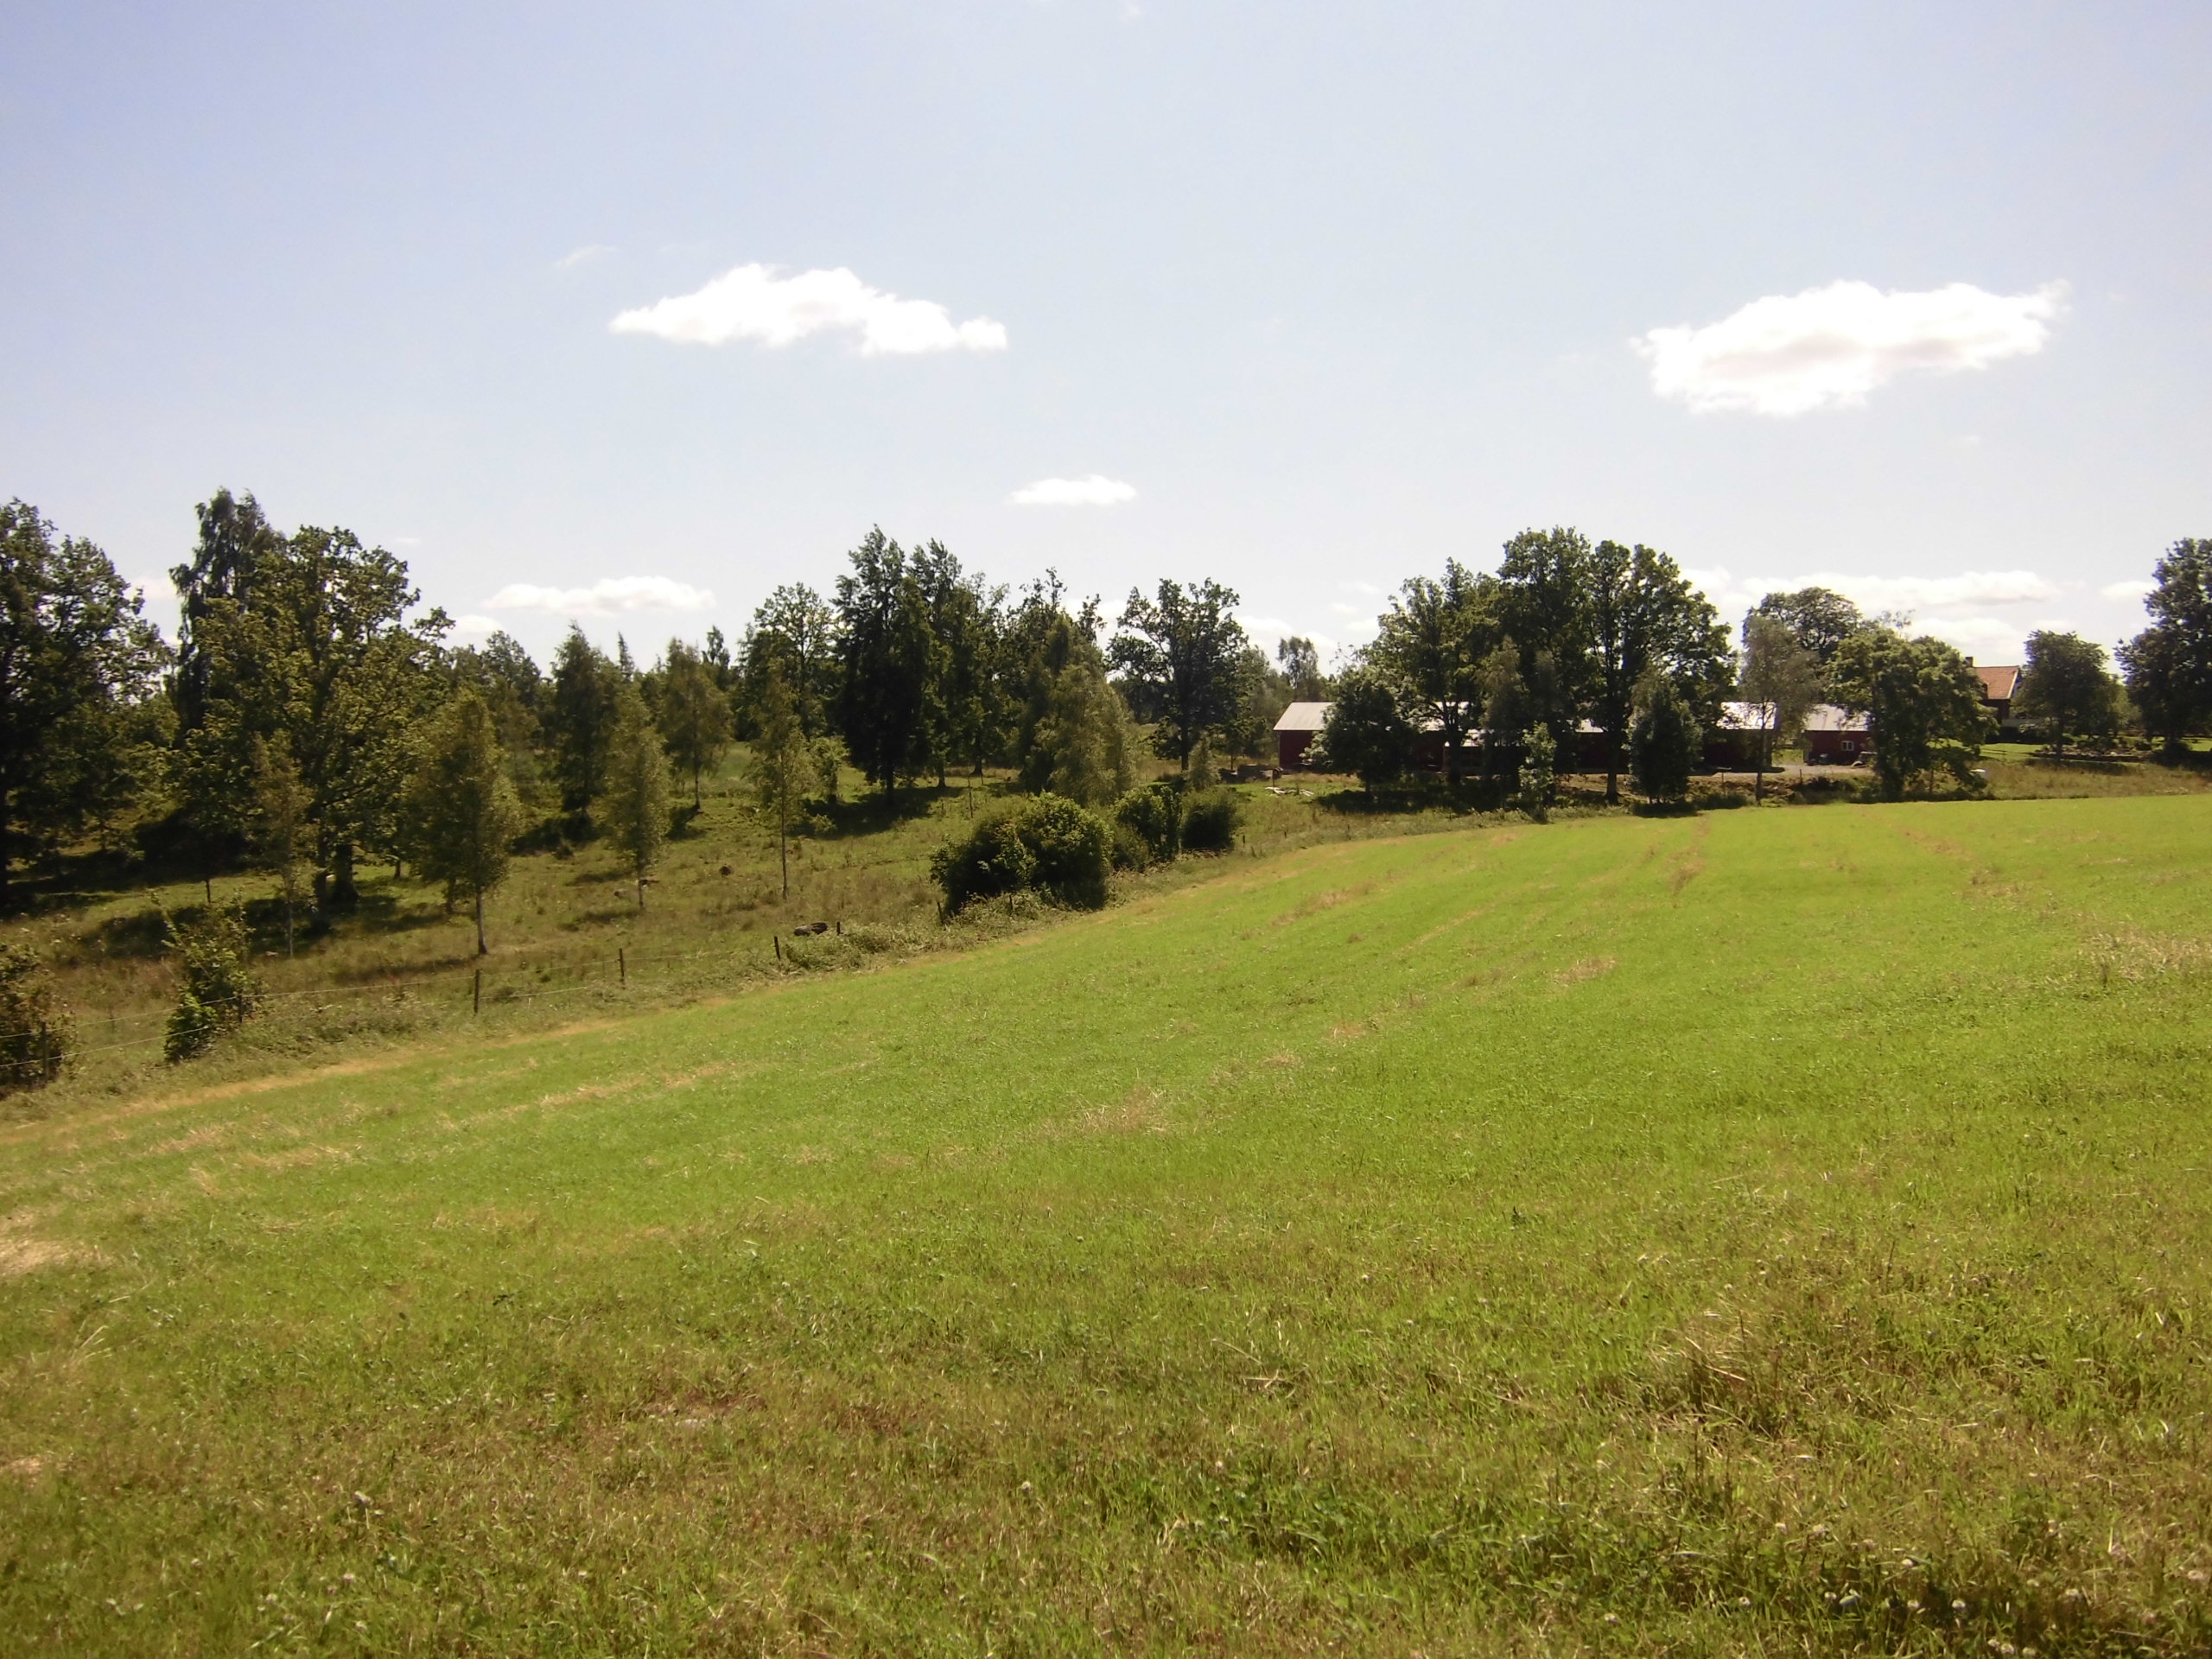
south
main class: Grassland
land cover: Grassland without tree/shrub cover
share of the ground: > 75 %
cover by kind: herbaceous plants 95 %, unconsolidated bare surface 5 %
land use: Agriculture (excluding fallow land and kitchen gardens)
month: July
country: SE
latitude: 57.3606
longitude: 15.2332
